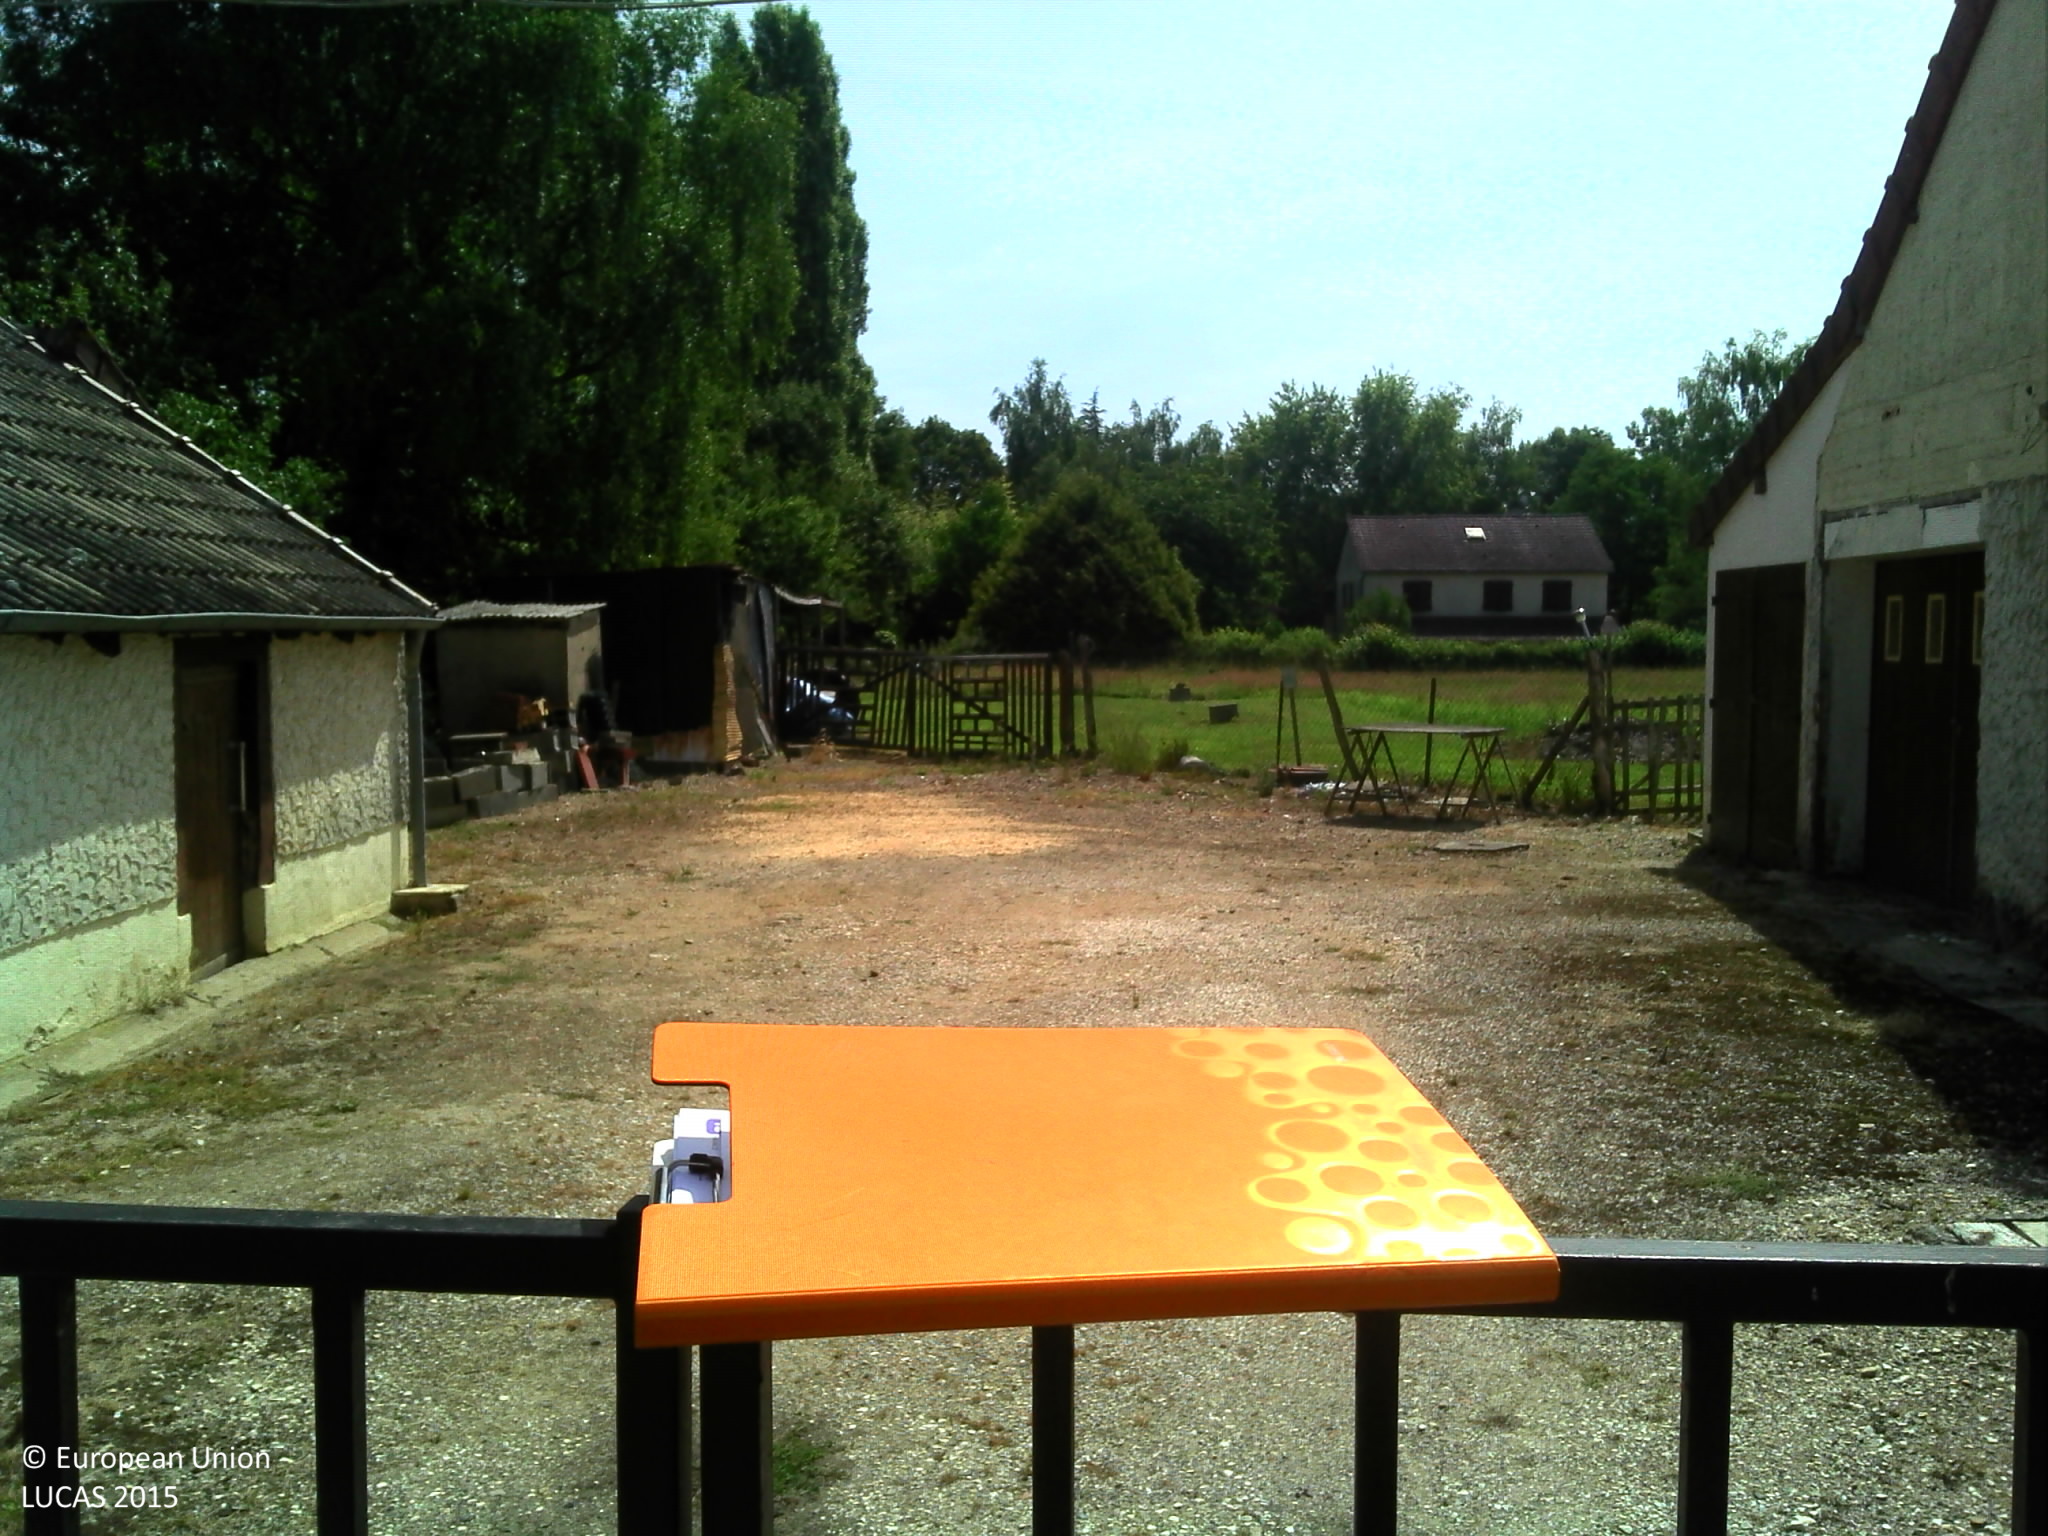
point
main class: Grassland
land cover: Grassland without tree/shrub cover
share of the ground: > 75 %
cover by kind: herbaceous plants 100 %
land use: Agriculture (excluding fallow land and kitchen gardens)
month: June
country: FR
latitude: 46.9526
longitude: 2.9924
